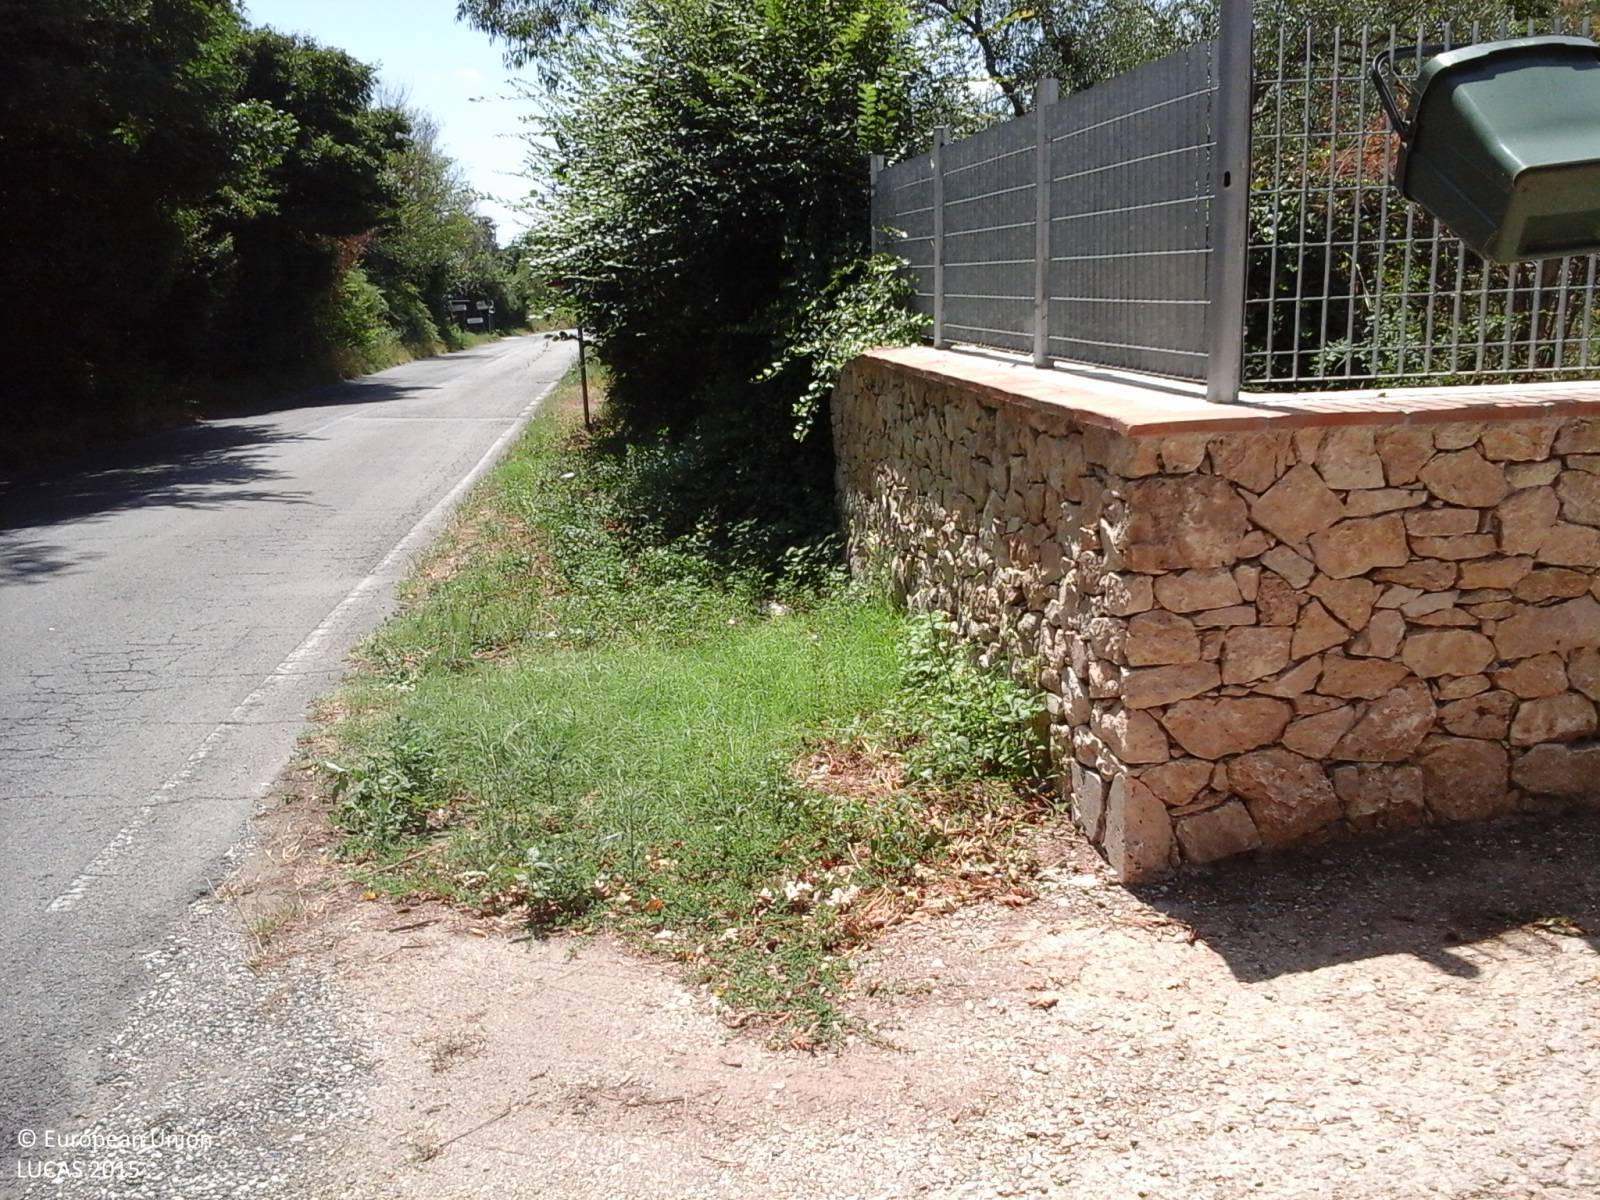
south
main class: Cropland
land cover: Olive groves
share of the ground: > 75 %
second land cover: Spontaneously vegetated surfaces
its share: > 75 %
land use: Kitchen garden
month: July
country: IT
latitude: 42.2250
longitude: 12.5234
